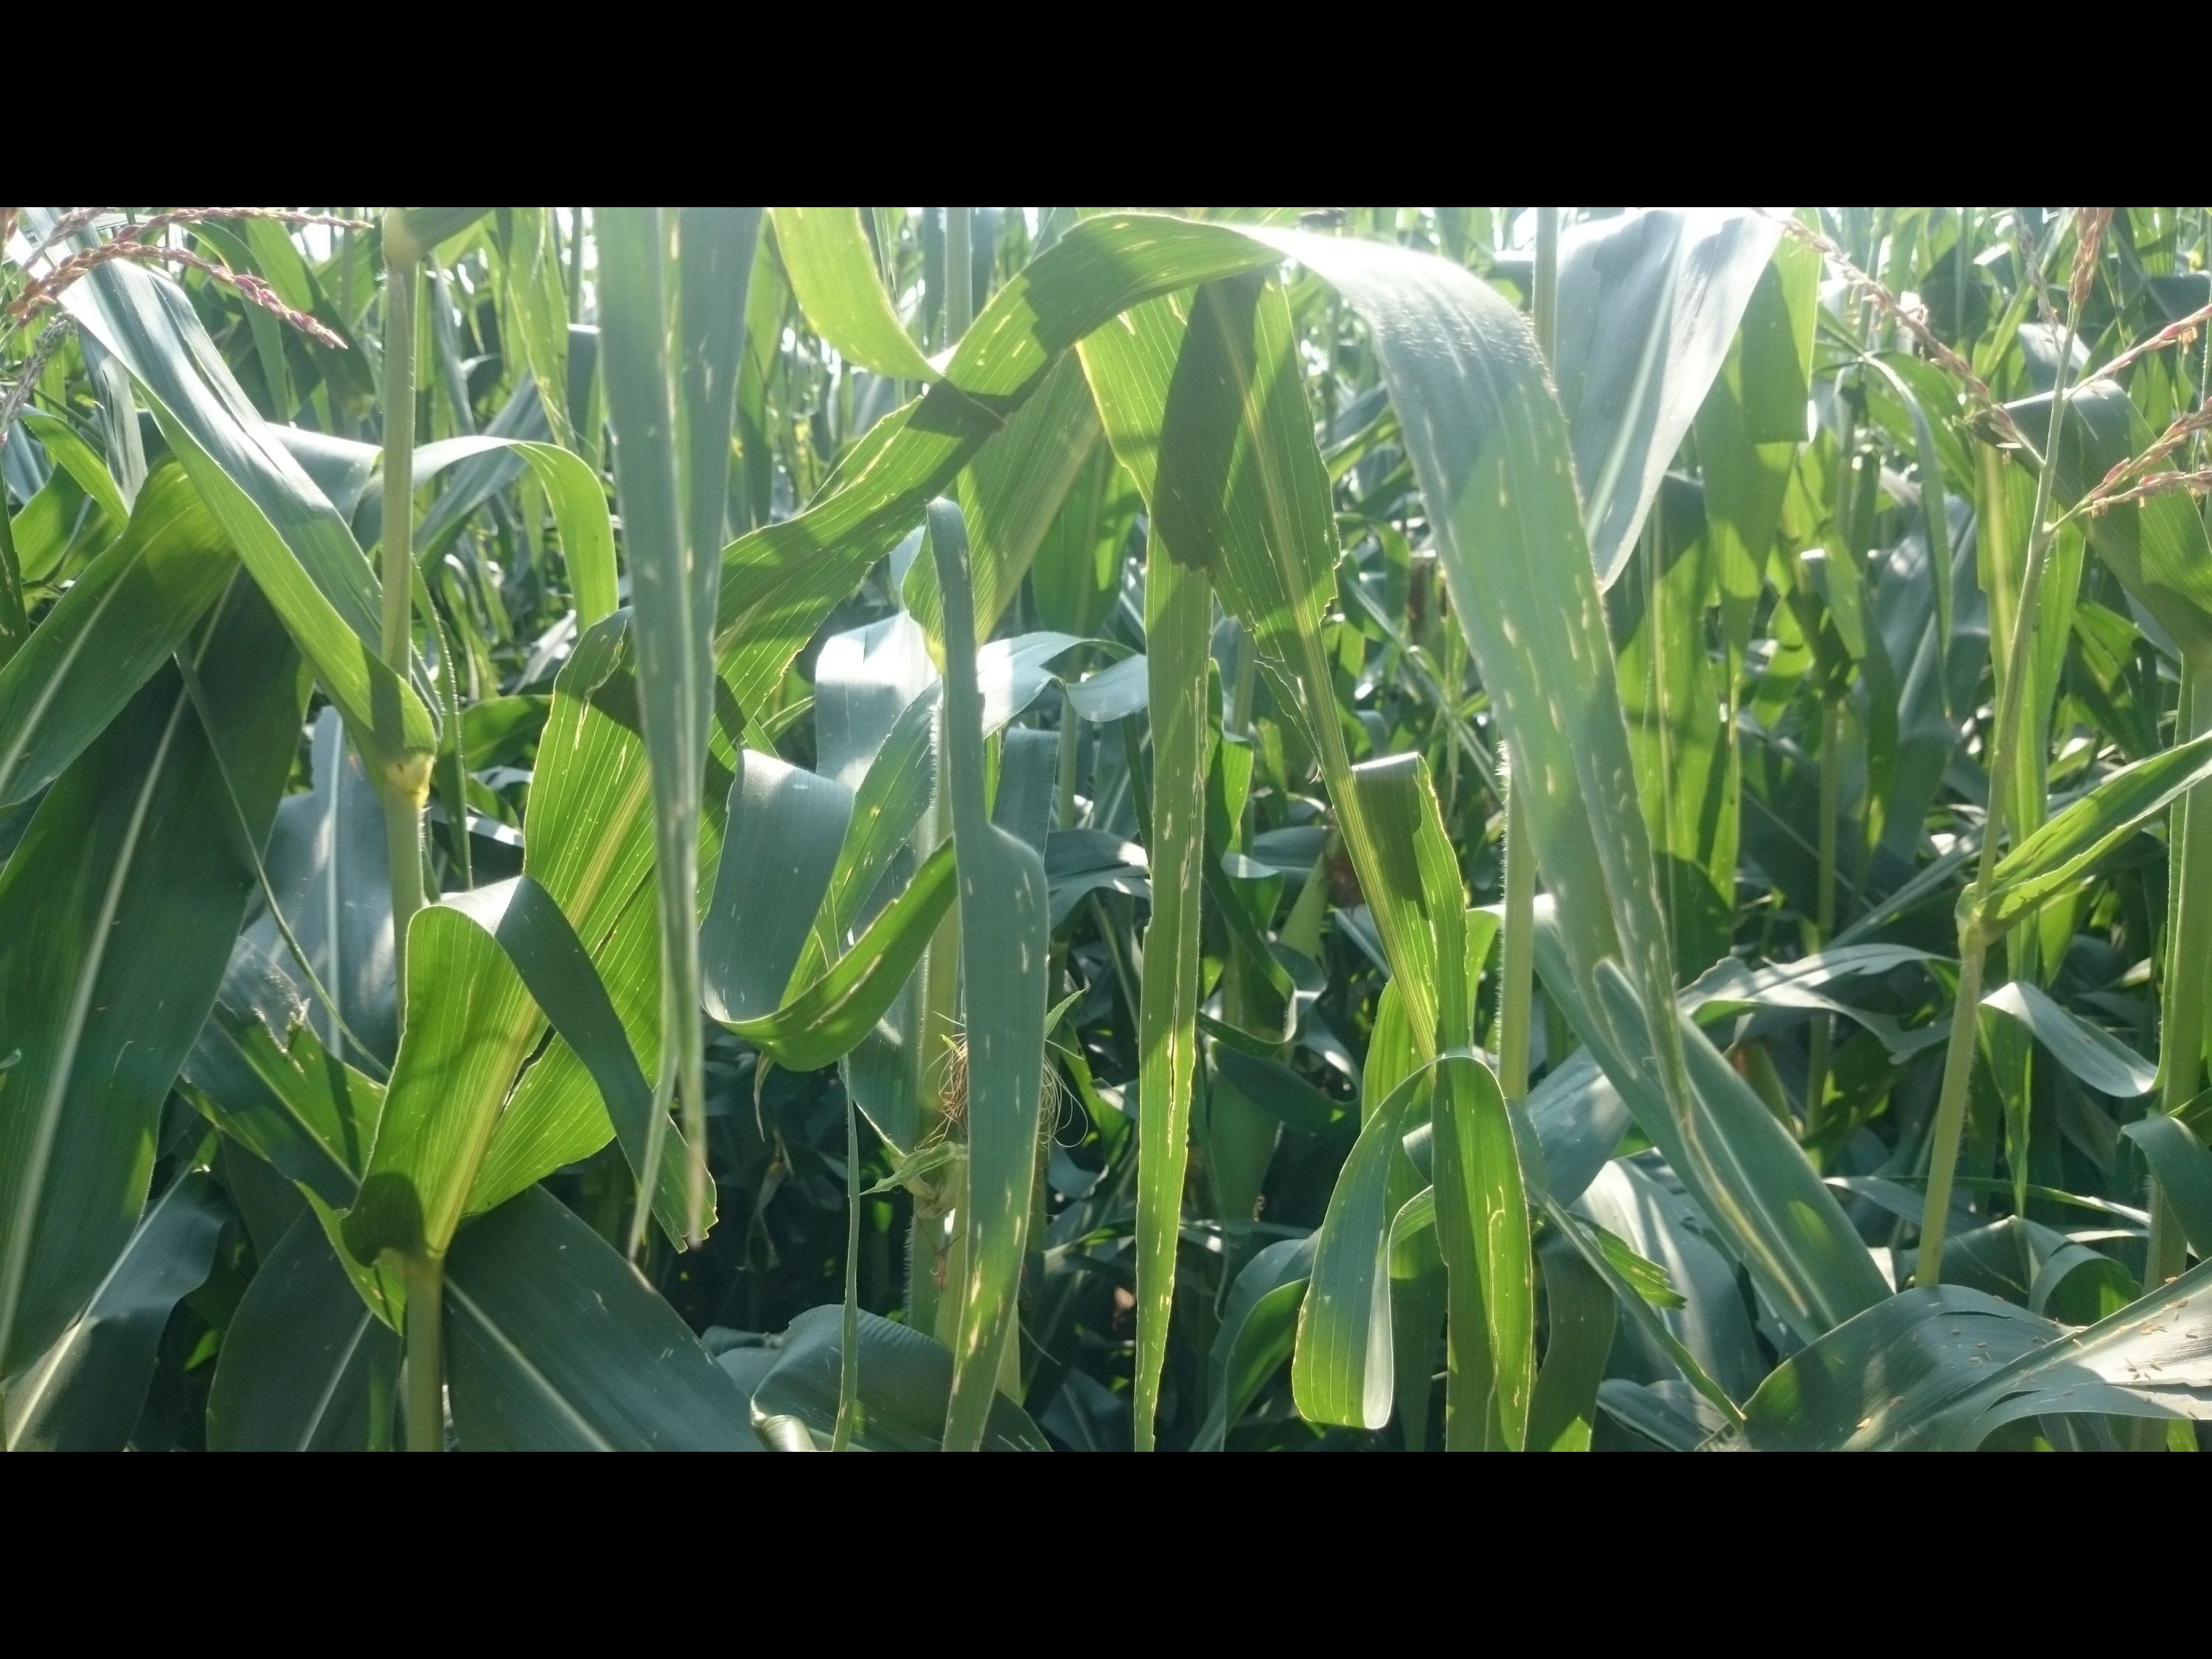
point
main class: Cropland
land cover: Maize
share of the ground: > 75 %
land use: Agriculture (excluding fallow land and kitchen gardens)
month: July
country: AT
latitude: 47.0531
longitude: 15.5949
